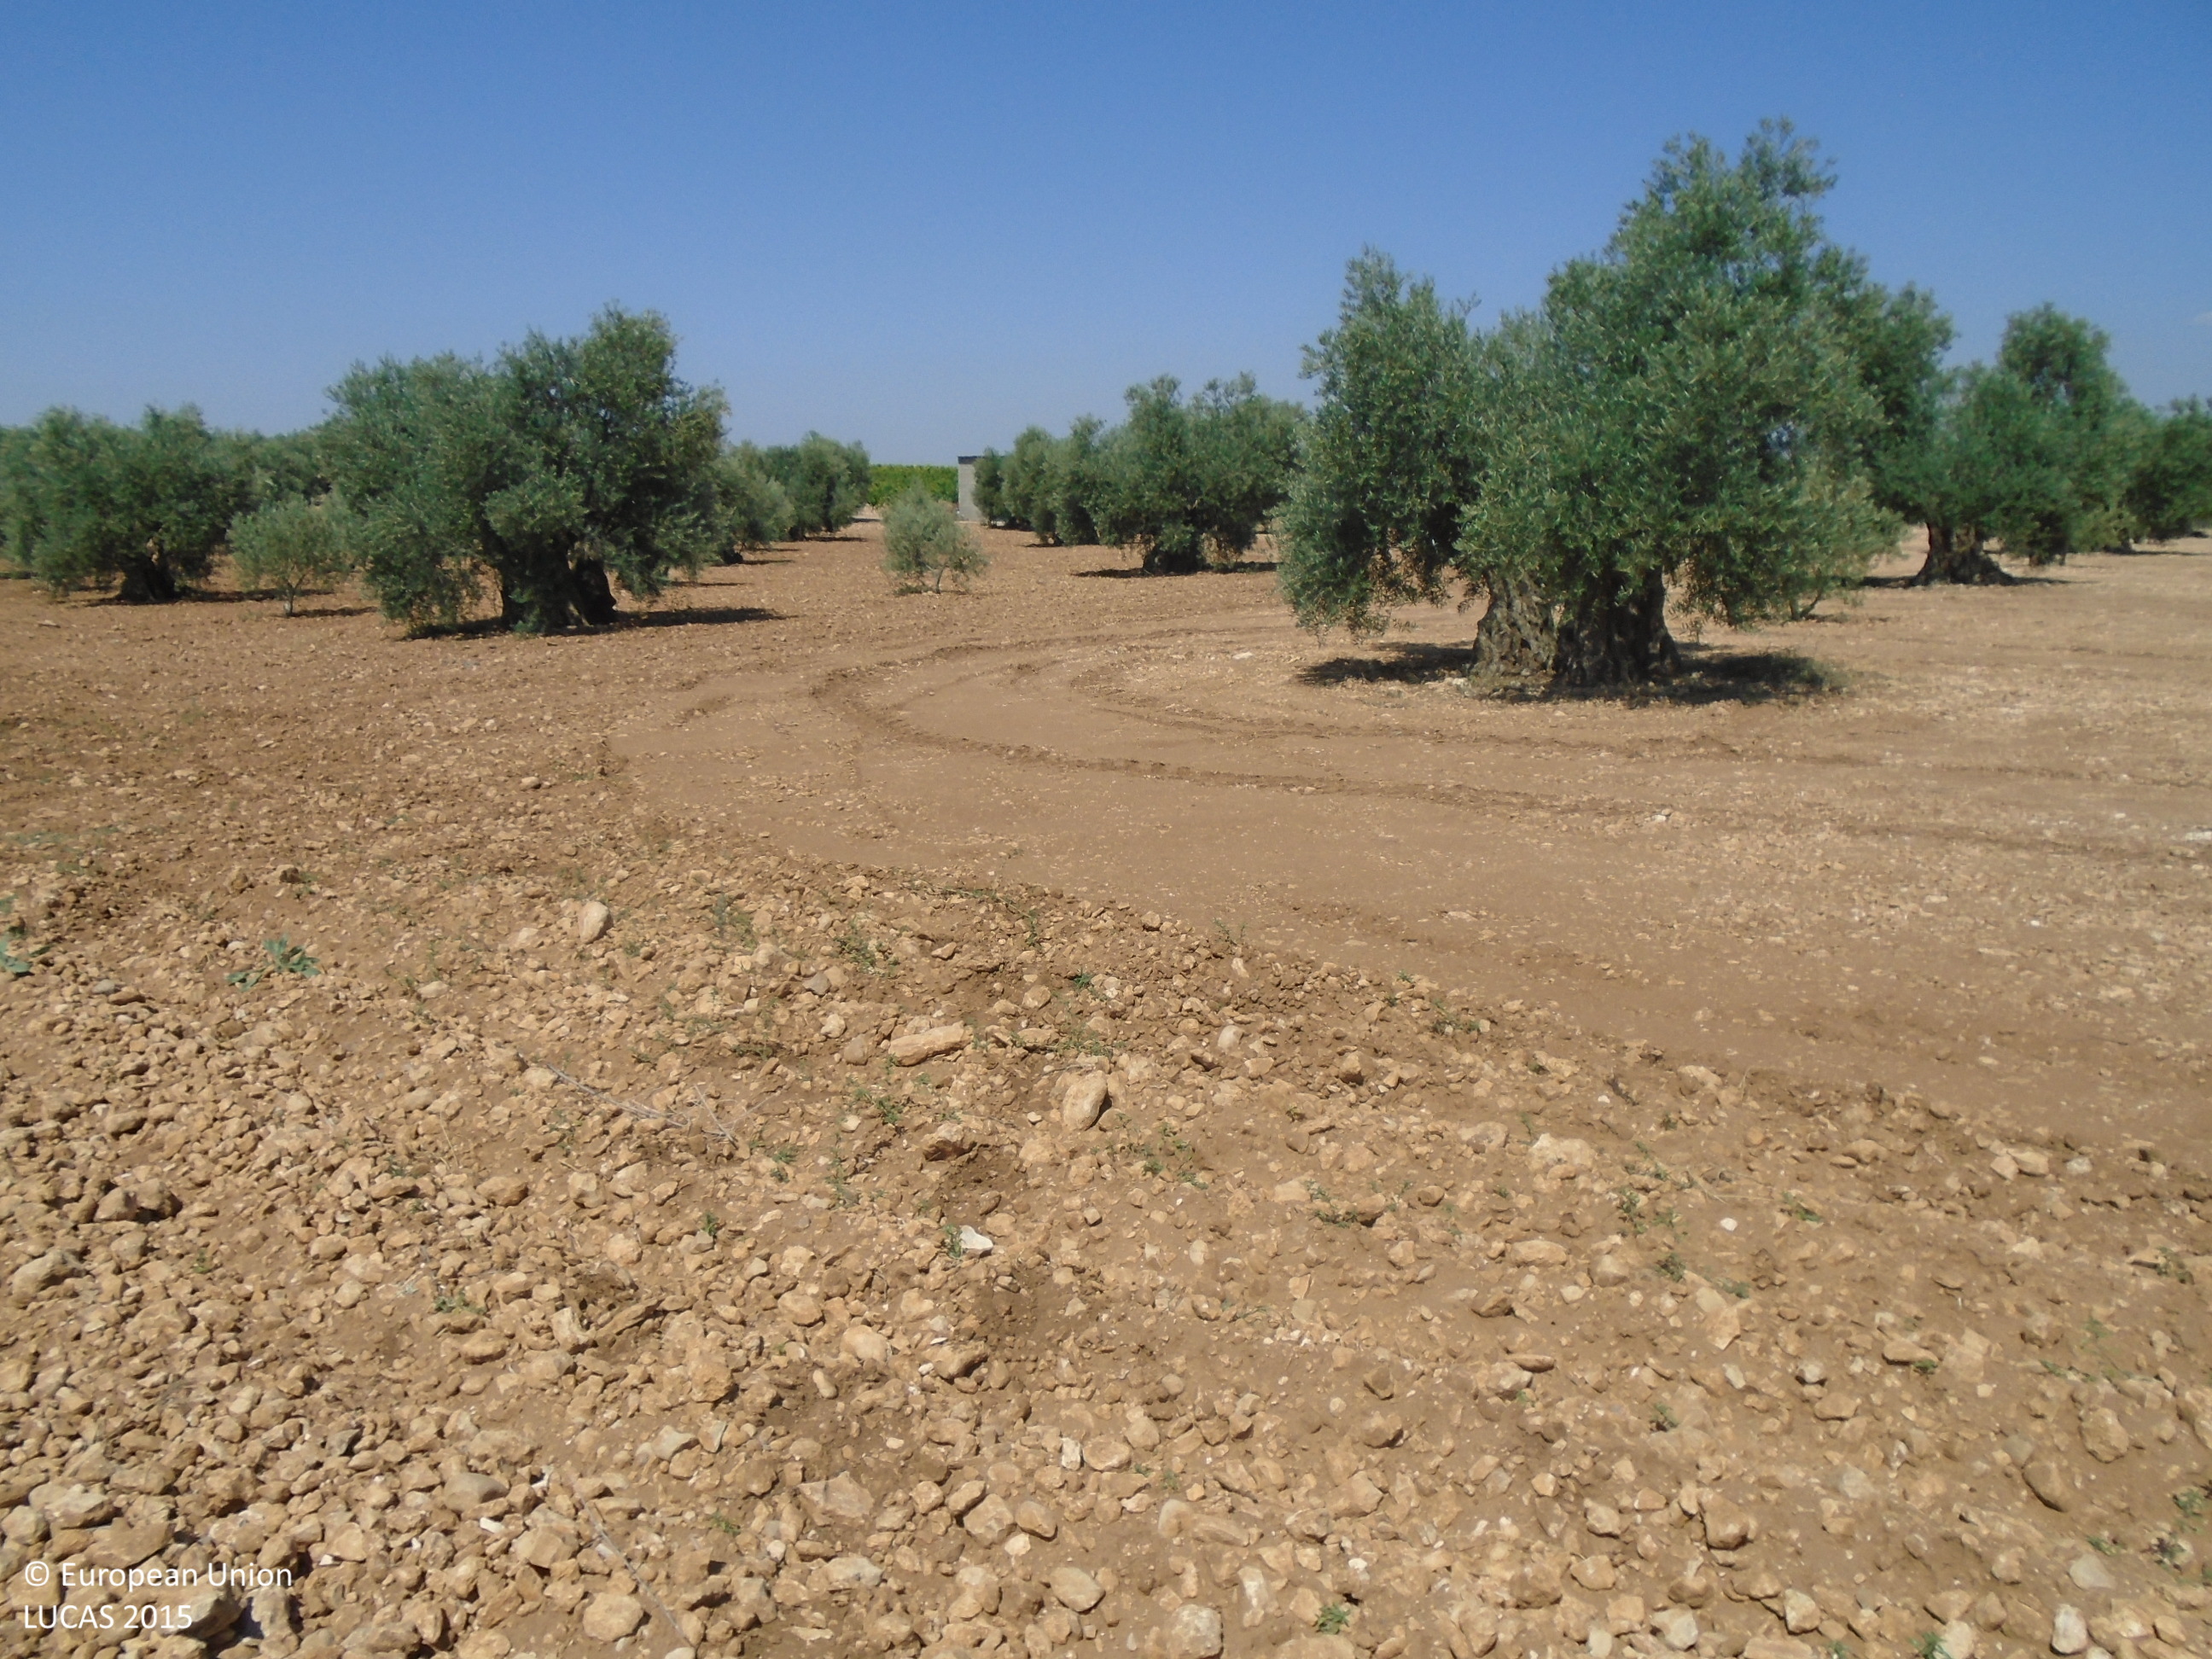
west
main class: Cropland
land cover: Olive groves
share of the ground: 10 - 25 %
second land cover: Other bare soil
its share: > 75 %
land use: Agriculture (excluding fallow land and kitchen gardens)
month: June
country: ES
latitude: 39.1630
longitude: -3.6414
